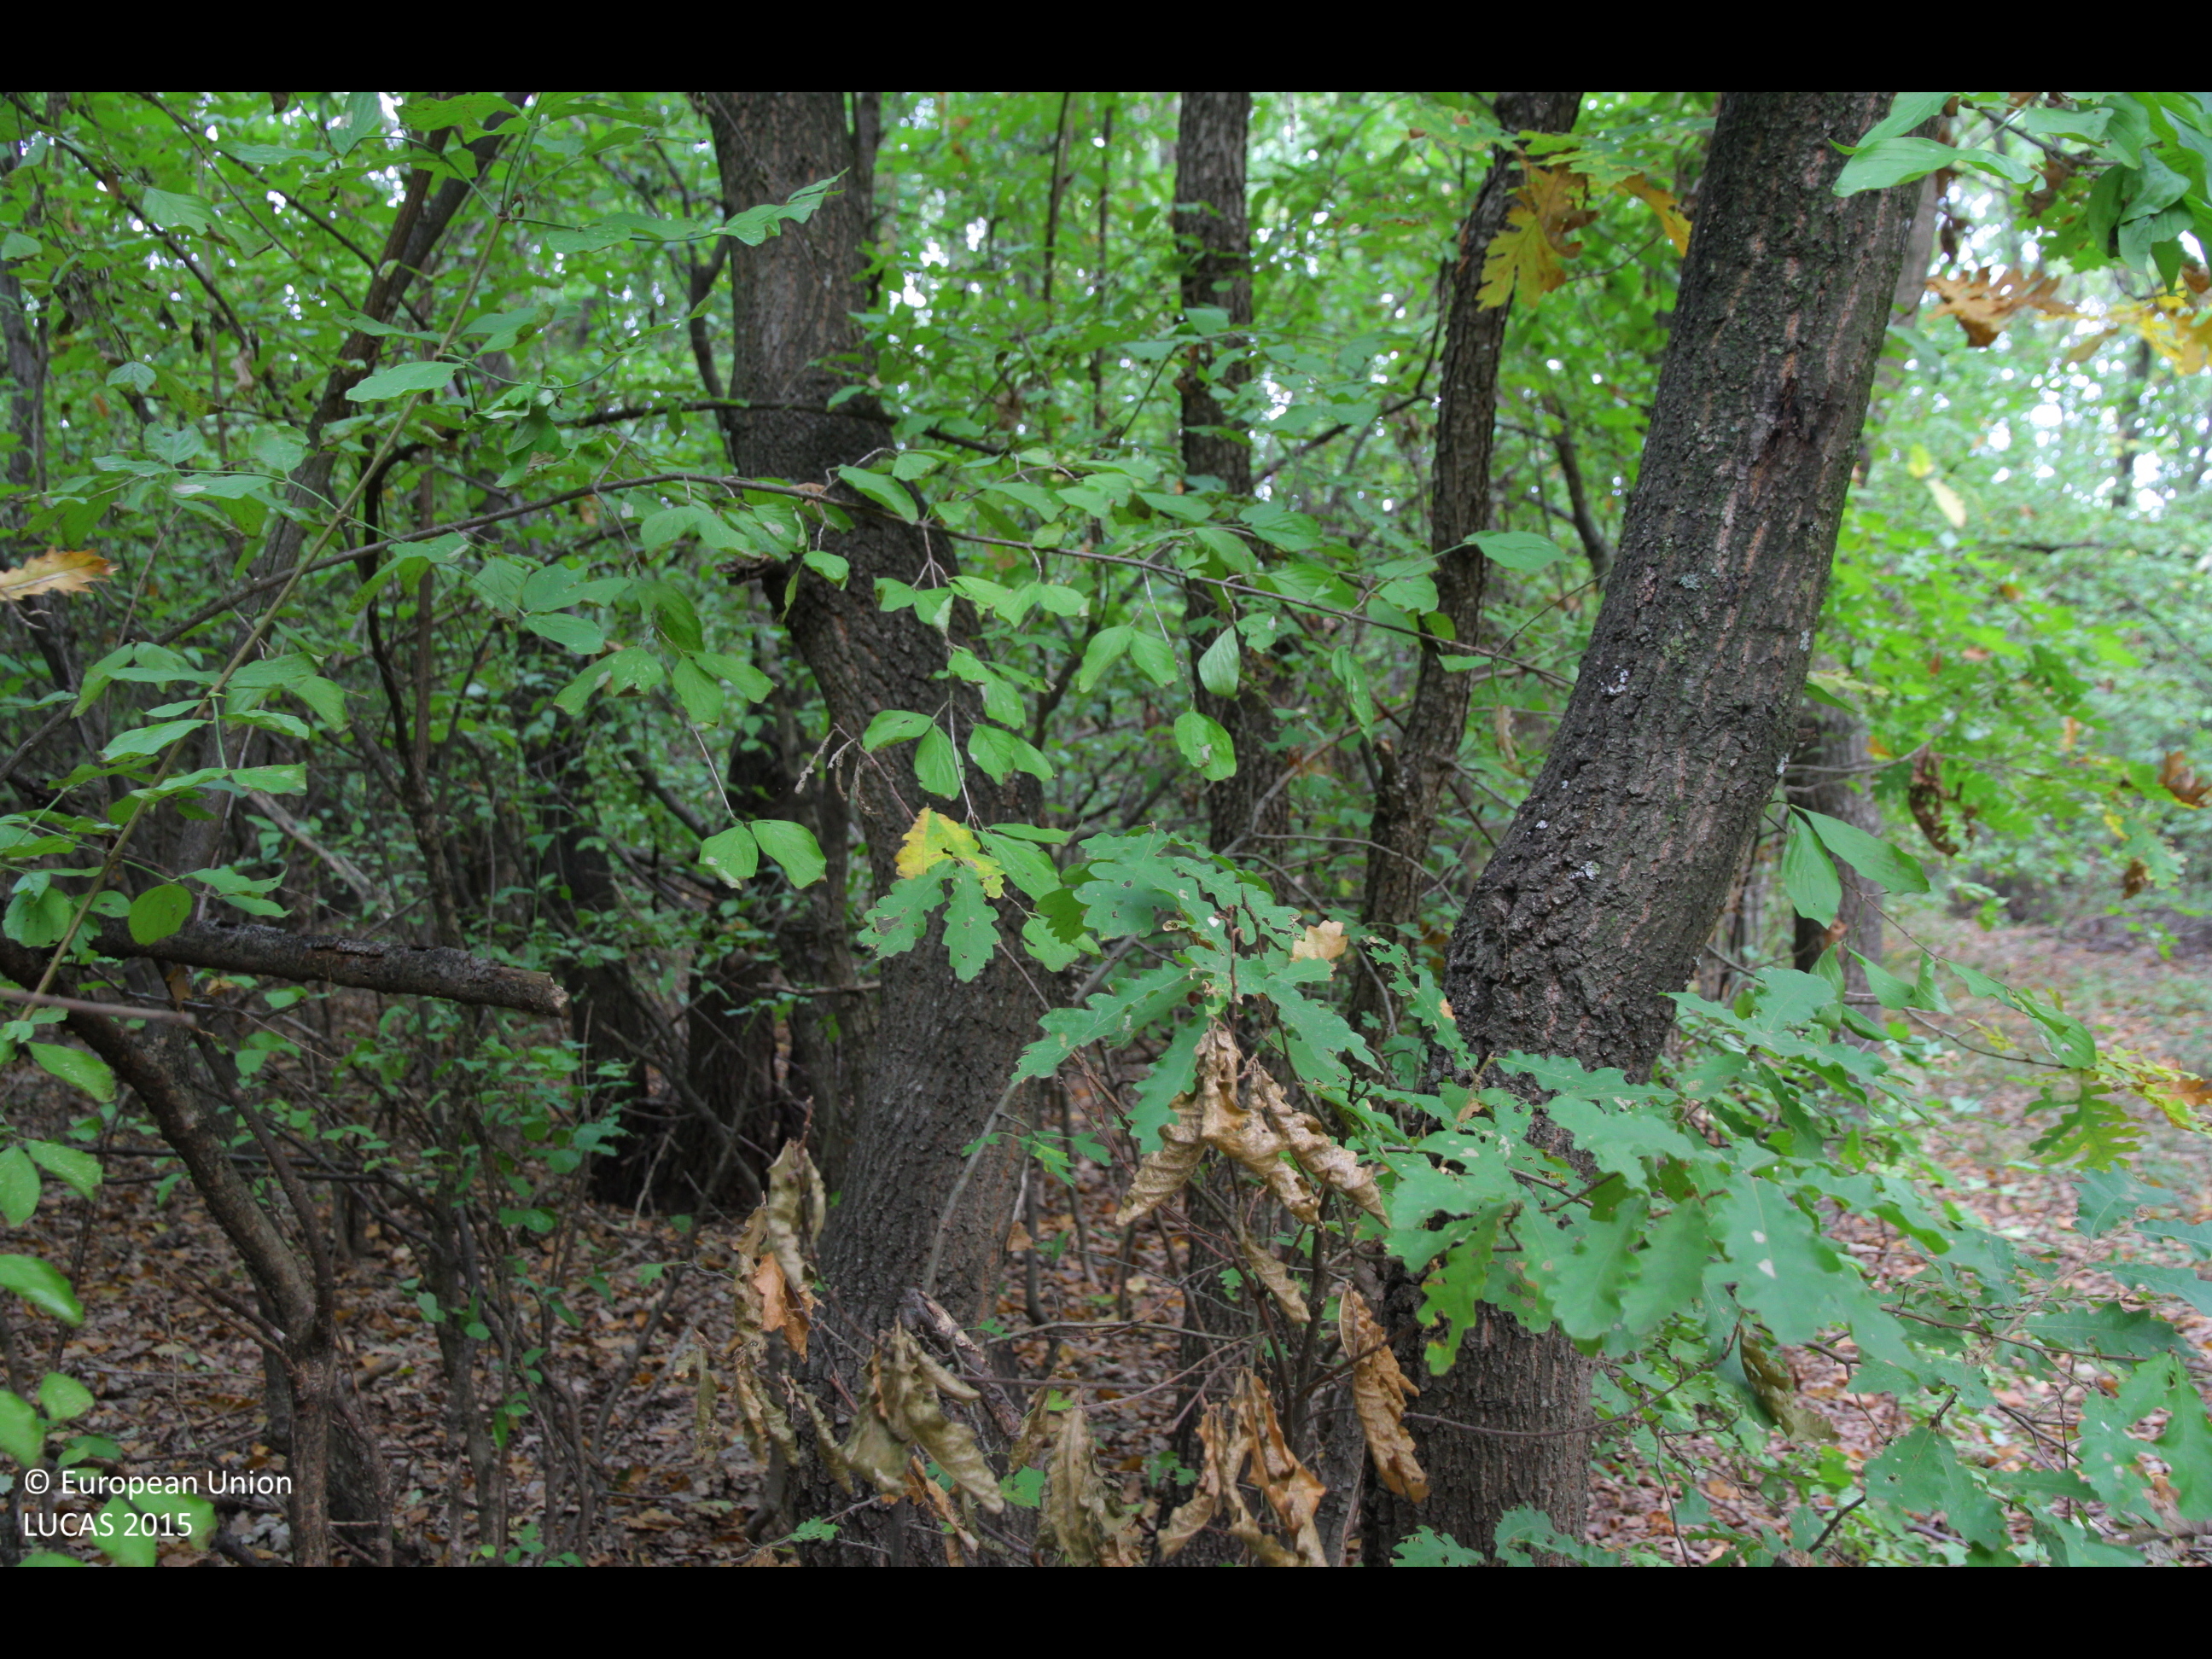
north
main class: Woodland
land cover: Broadleaved woodland
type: mesophytic deciduous forest
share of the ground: > 75 %
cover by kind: broadleaved forest trees 95 %, shrubs 5 %
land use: Forestry
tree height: > 5 m
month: October
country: BG
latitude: 43.5622
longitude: 26.9922
